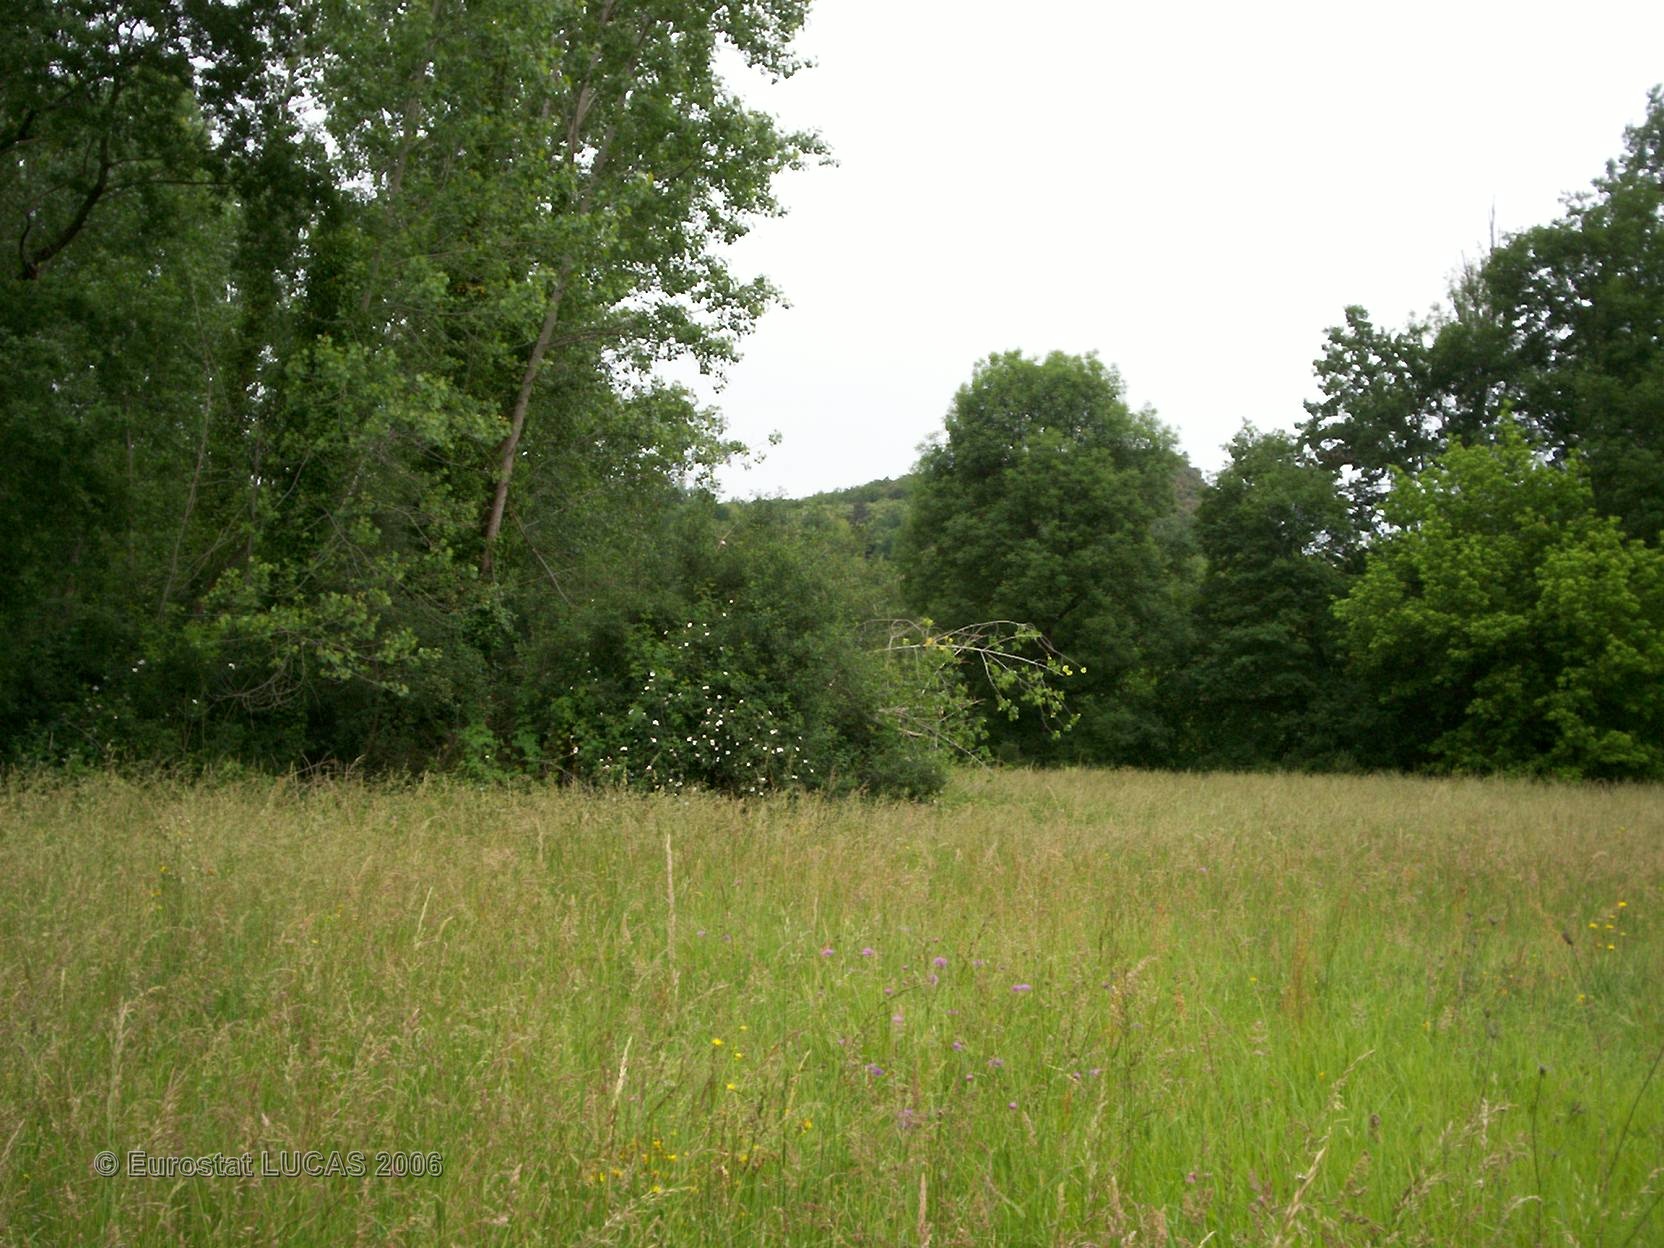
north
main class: Grassland
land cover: Grassland without tree/shrub cover
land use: Agriculture (excluding fallow land and kitchen gardens)
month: May
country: FR
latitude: 44.8591
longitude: 1.3524
